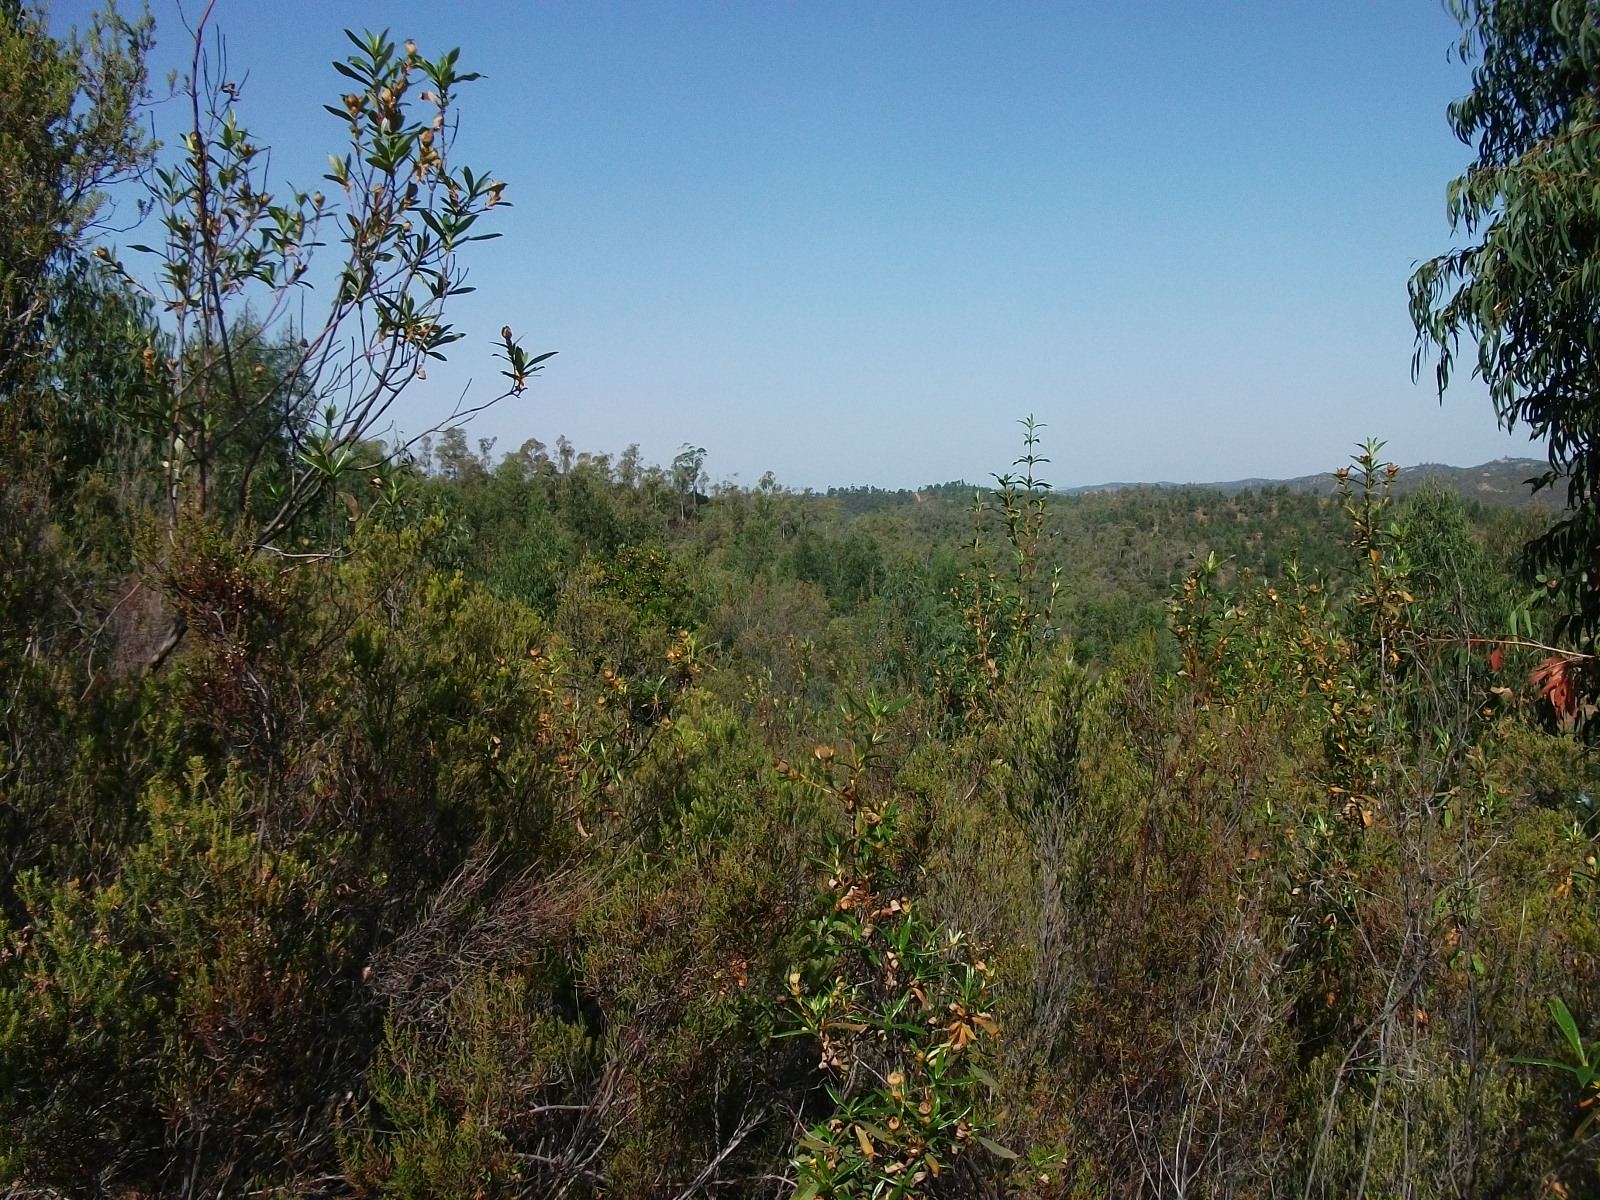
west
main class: Woodland
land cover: Broadleaved woodland
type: exotic forest
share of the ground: 50 - 75 %
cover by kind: broadleaved forest trees 60 %, shrubs 30 %, unconsolidated bare surface 10 %
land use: Forestry
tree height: > 5 m
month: May
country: ES
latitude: 37.5968
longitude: -6.6549
